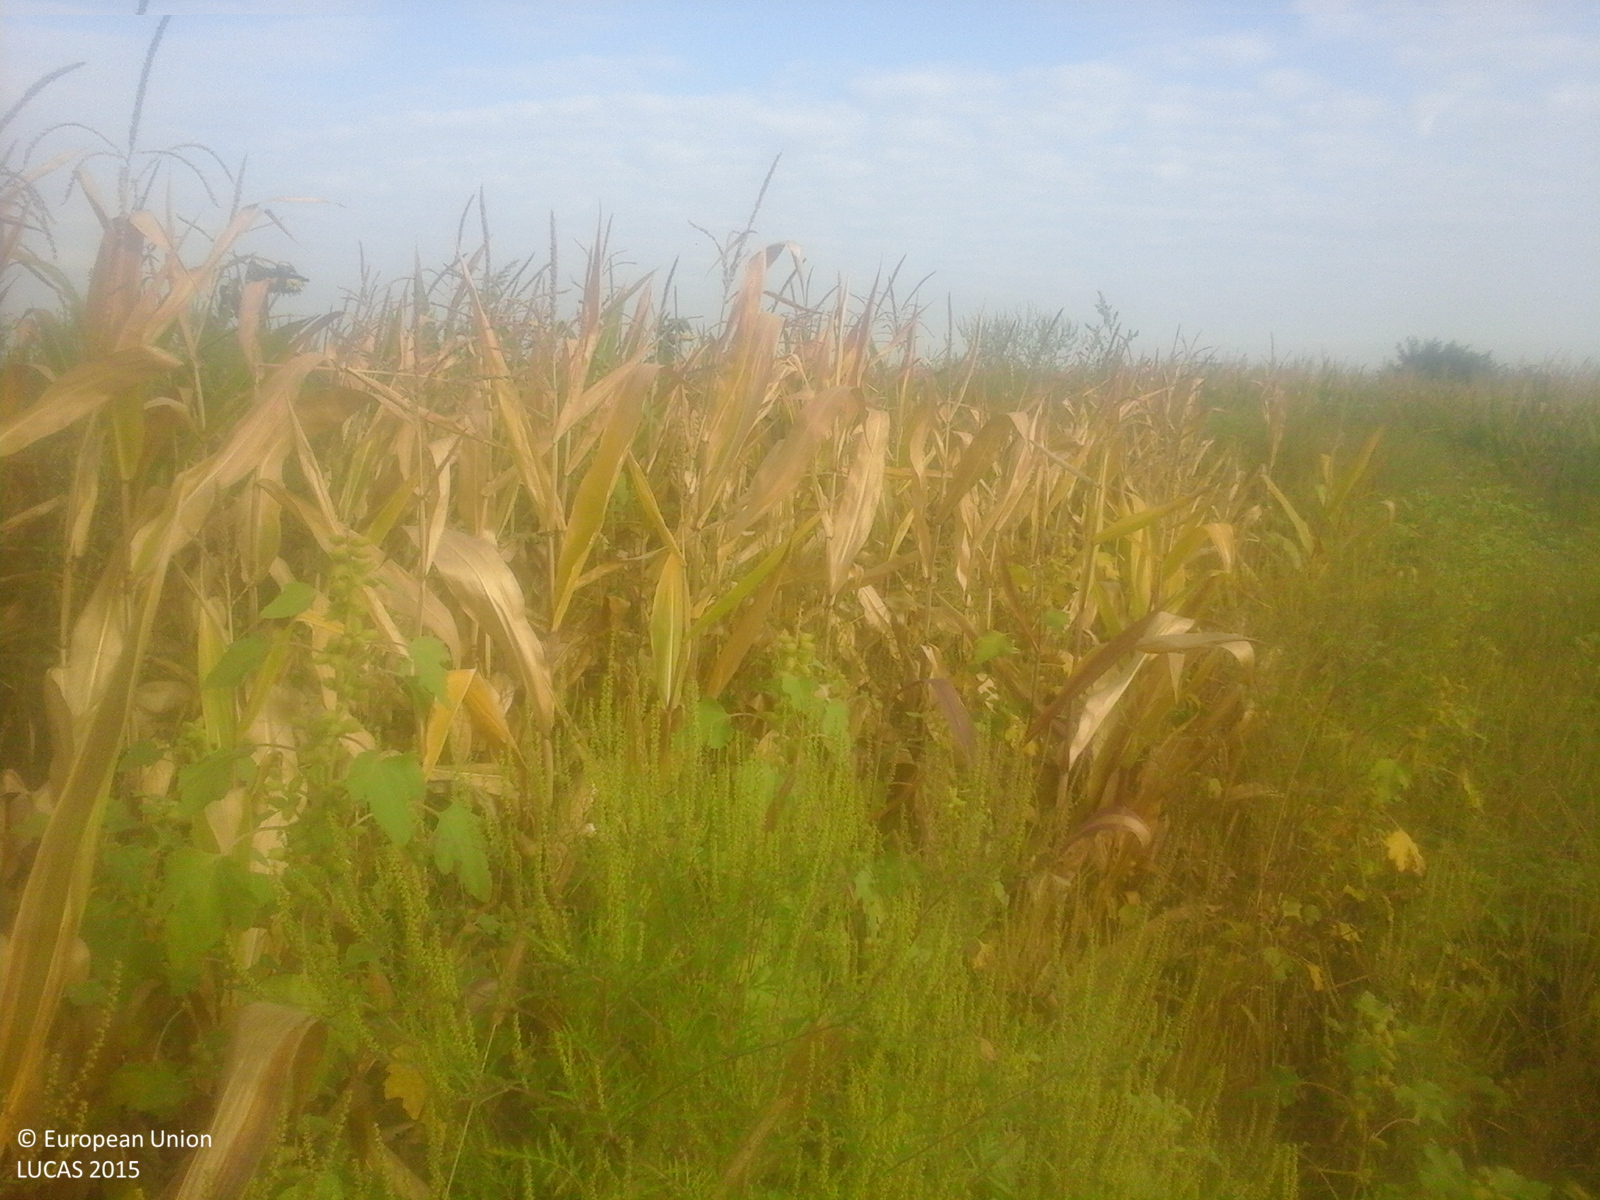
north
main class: Cropland
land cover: Maize
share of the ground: > 75 %
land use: Agriculture (excluding fallow land and kitchen gardens)
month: September
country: RO
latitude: 47.7915
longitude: 22.7304
